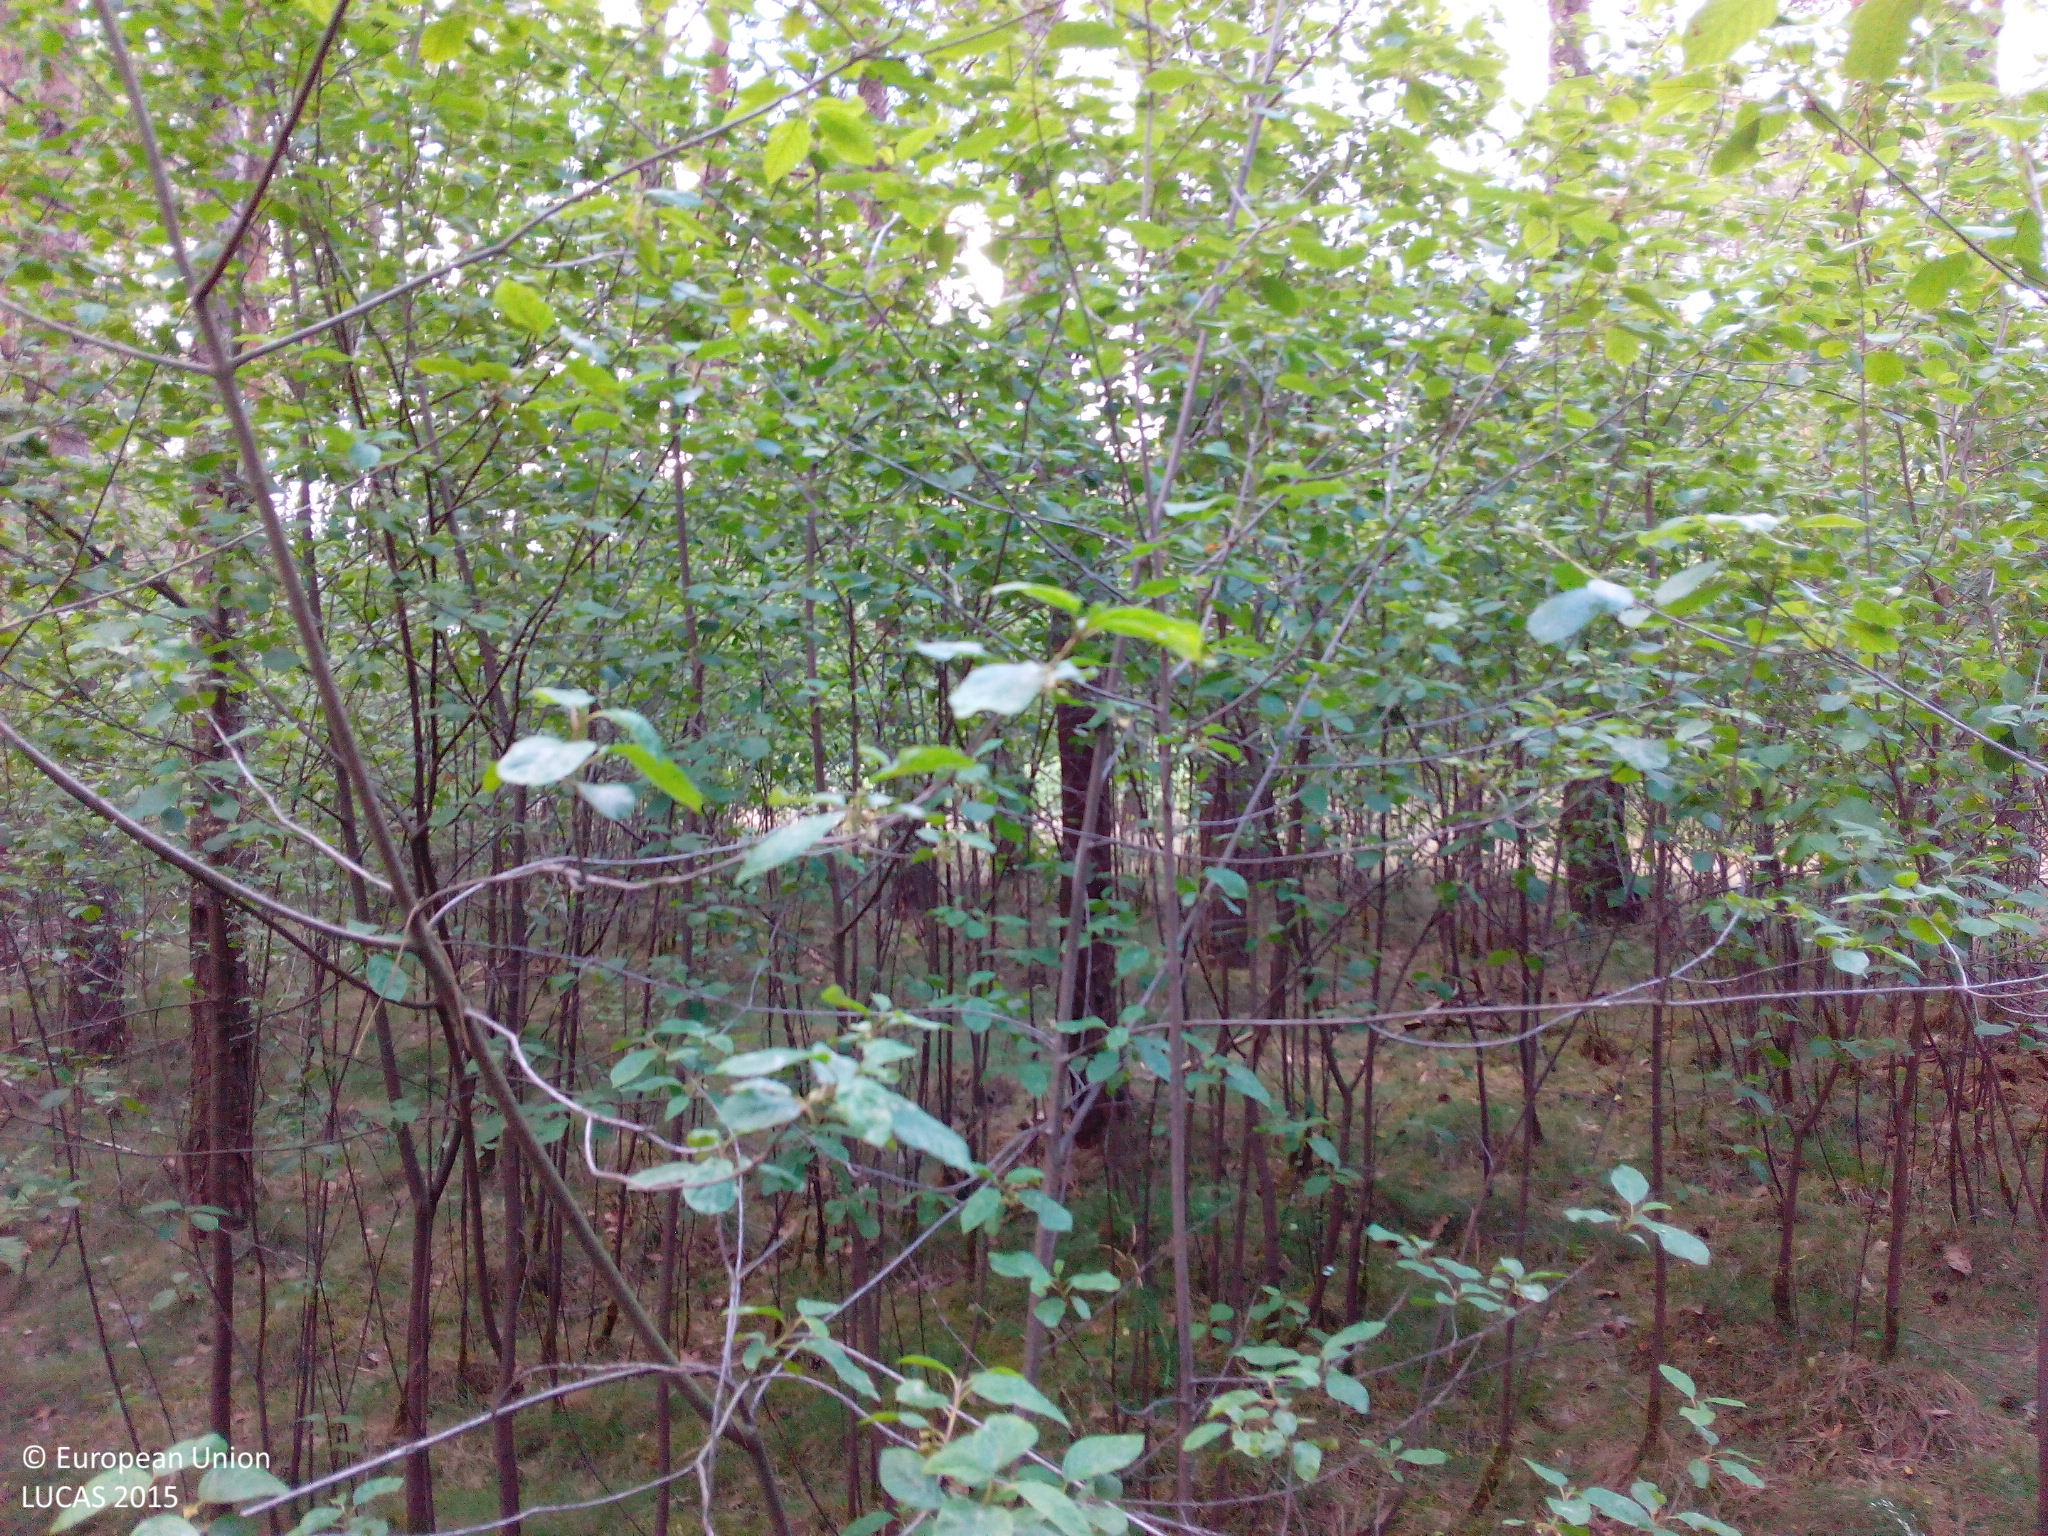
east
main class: Woodland
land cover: Pine dominated coniferous woodland
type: hemiboreal forest and nemoral coniferous forest and mixed broadleaved-coniferous forest
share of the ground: 50 - 75 %
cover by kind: coniferous forest trees 70 %, shrubs 15 %, herbaceous plants 10 %, broadleaved forest trees 5 %
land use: Forestry
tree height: > 5 m
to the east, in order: Pine dominated coniferous woodland; Tracks; Pine dominated coniferous woodland
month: June
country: DE
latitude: 52.6371
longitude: 7.4145
